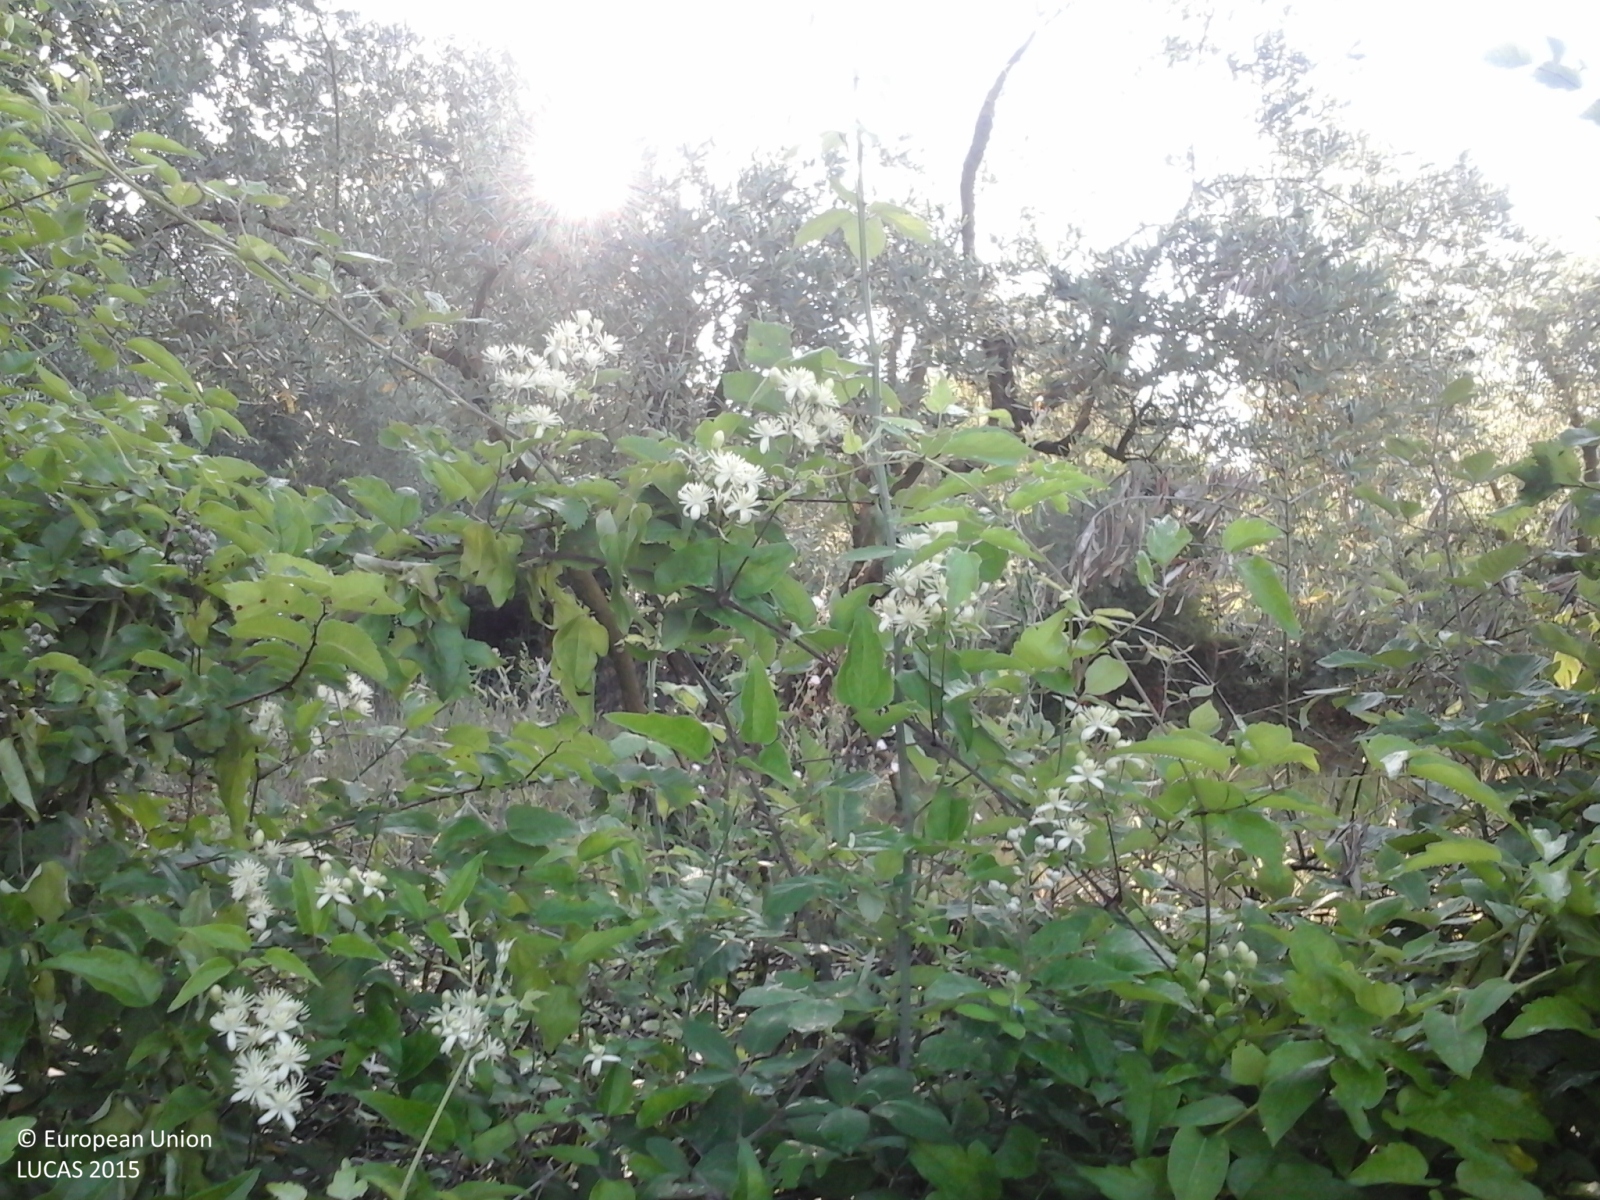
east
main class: Woodland
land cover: Broadleaved woodland
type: thermophilous deciduous forest
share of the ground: > 75 %
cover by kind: shrubs 70 %, broadleaved forest trees 15 %, herbaceous plants 15 %
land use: Abandoned areas
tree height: < 5 m
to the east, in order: Broadleaved woodland; Olive groves; Artificial constructions in urban areas; Broadleaved woodland; Paved roads, cycling and walking lanes; Broadleaved woodland; Electric lines; Olive groves; Abandoned hedges; Broadleaved woodland; Electric lines; Single bushes/trees; Tracks; Olive groves
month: June
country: IT
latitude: 41.6202
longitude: 13.4076
